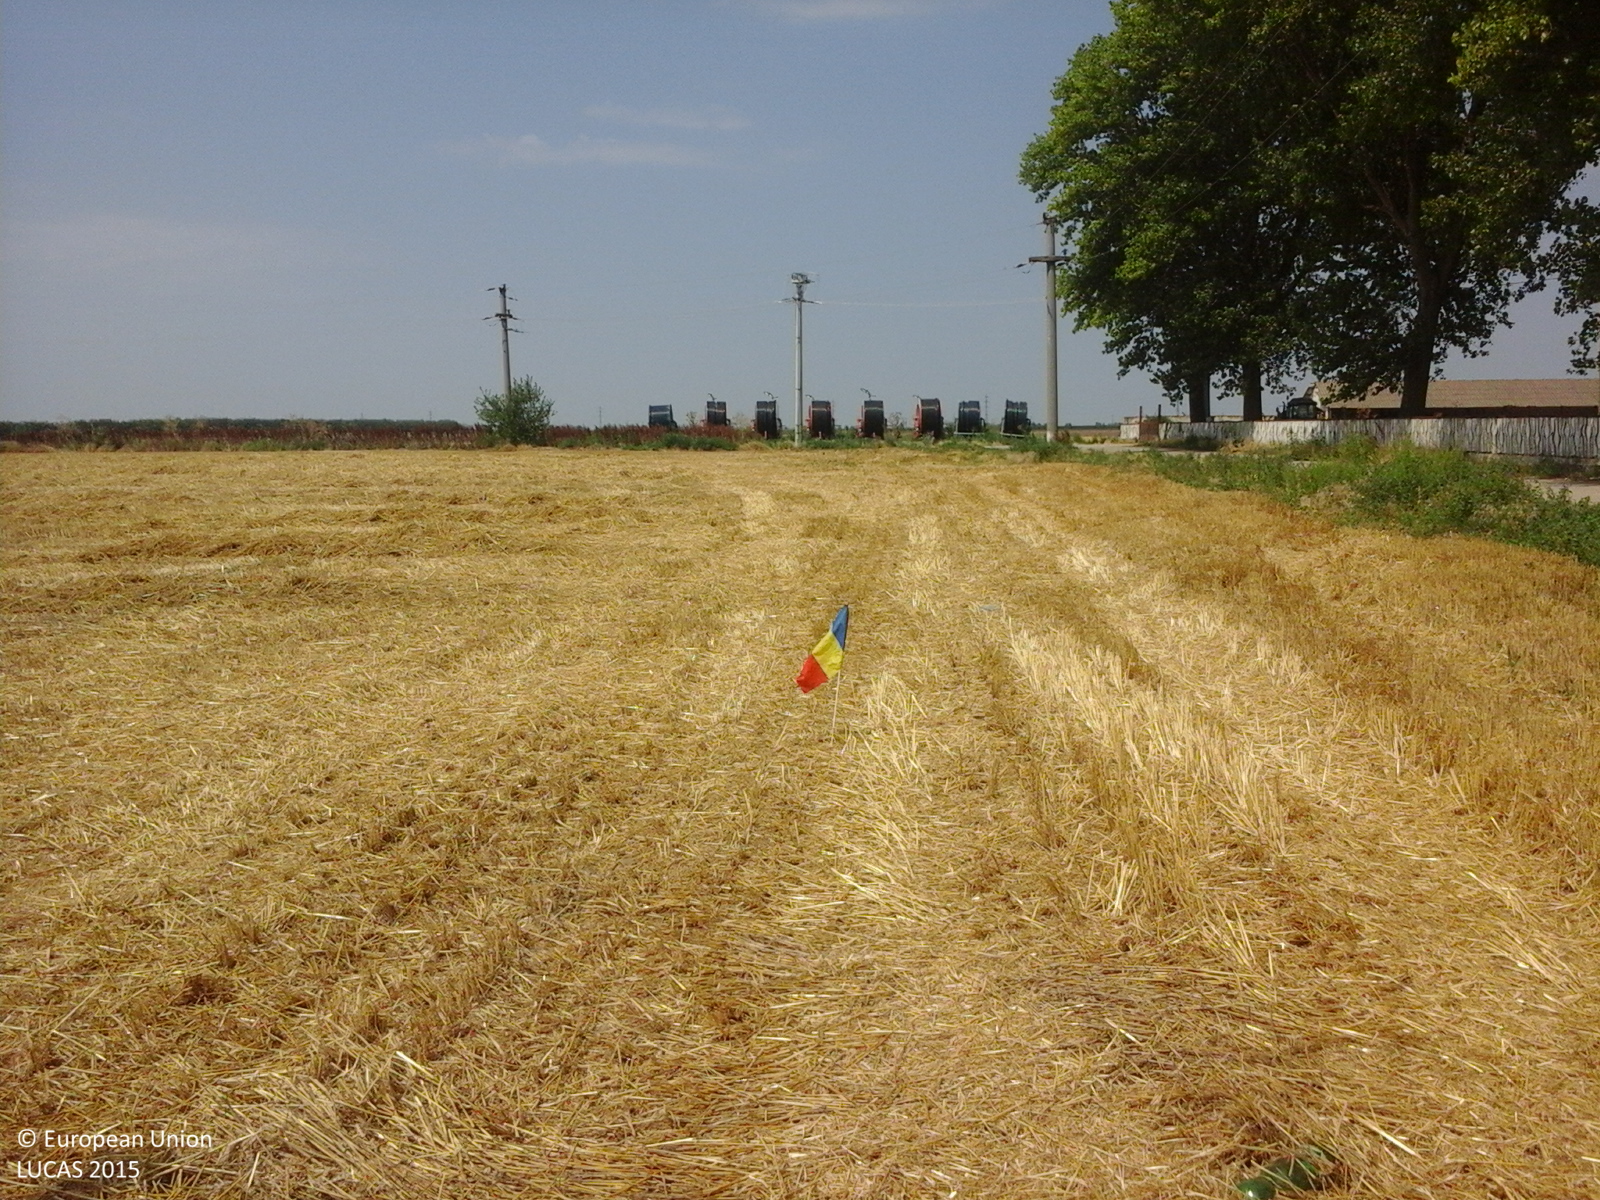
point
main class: Cropland
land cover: Common wheat
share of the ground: < 10 %
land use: Agriculture (excluding fallow land and kitchen gardens)
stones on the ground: < 10 %
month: July
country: RO
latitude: 44.6404
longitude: 27.5828
